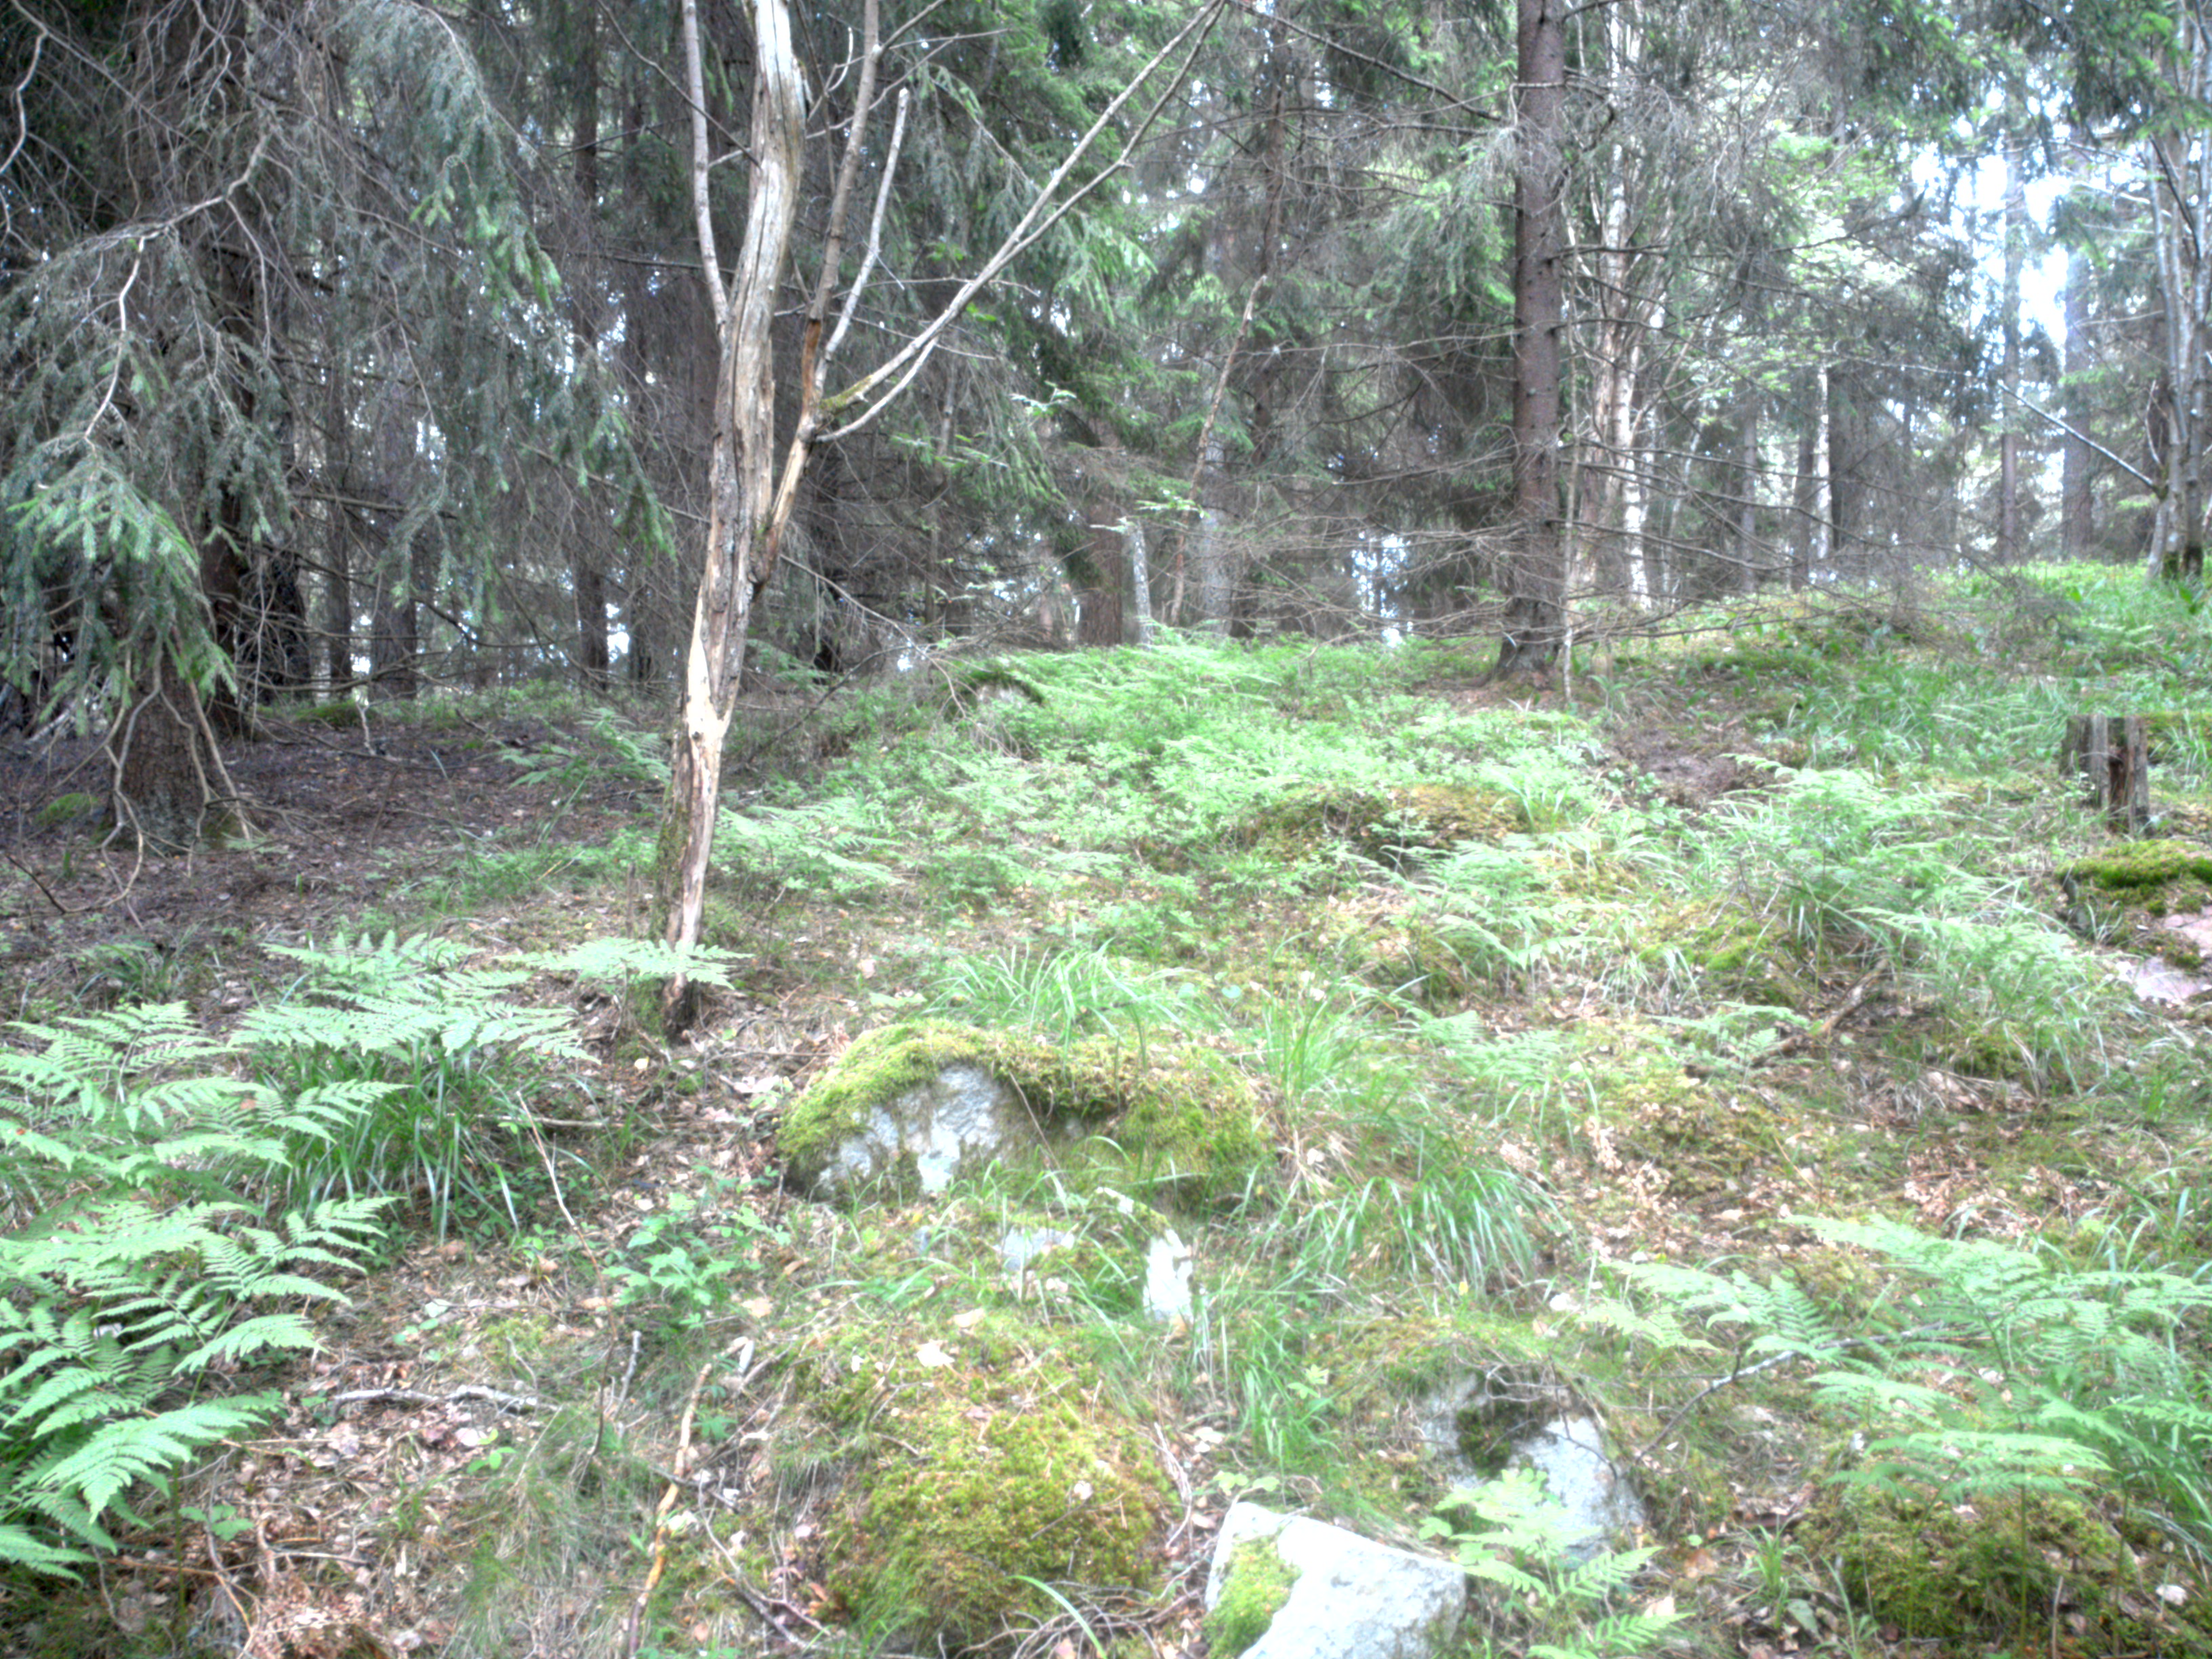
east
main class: Woodland
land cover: Spruce dominated mixed woodland
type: boreal forest
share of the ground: 50 - 75 %
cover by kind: coniferous forest trees 50 %, broadleaved forest trees 20 %, lichens and mosses 20 %, herbaceous plants 10 %
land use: Forestry
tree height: > 5 m
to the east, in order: Spruce dominated mixed woodland; Tracks; Spruce dominated coniferous woodland; Spruce dominated mixed woodland; Tracks; Broadleaved woodland; Barley; Electric lines; Barley; Grass margins; Ditches and canals; Grassland with sparse tree/shrub cover
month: June
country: SE
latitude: 59.4215
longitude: 17.8042
